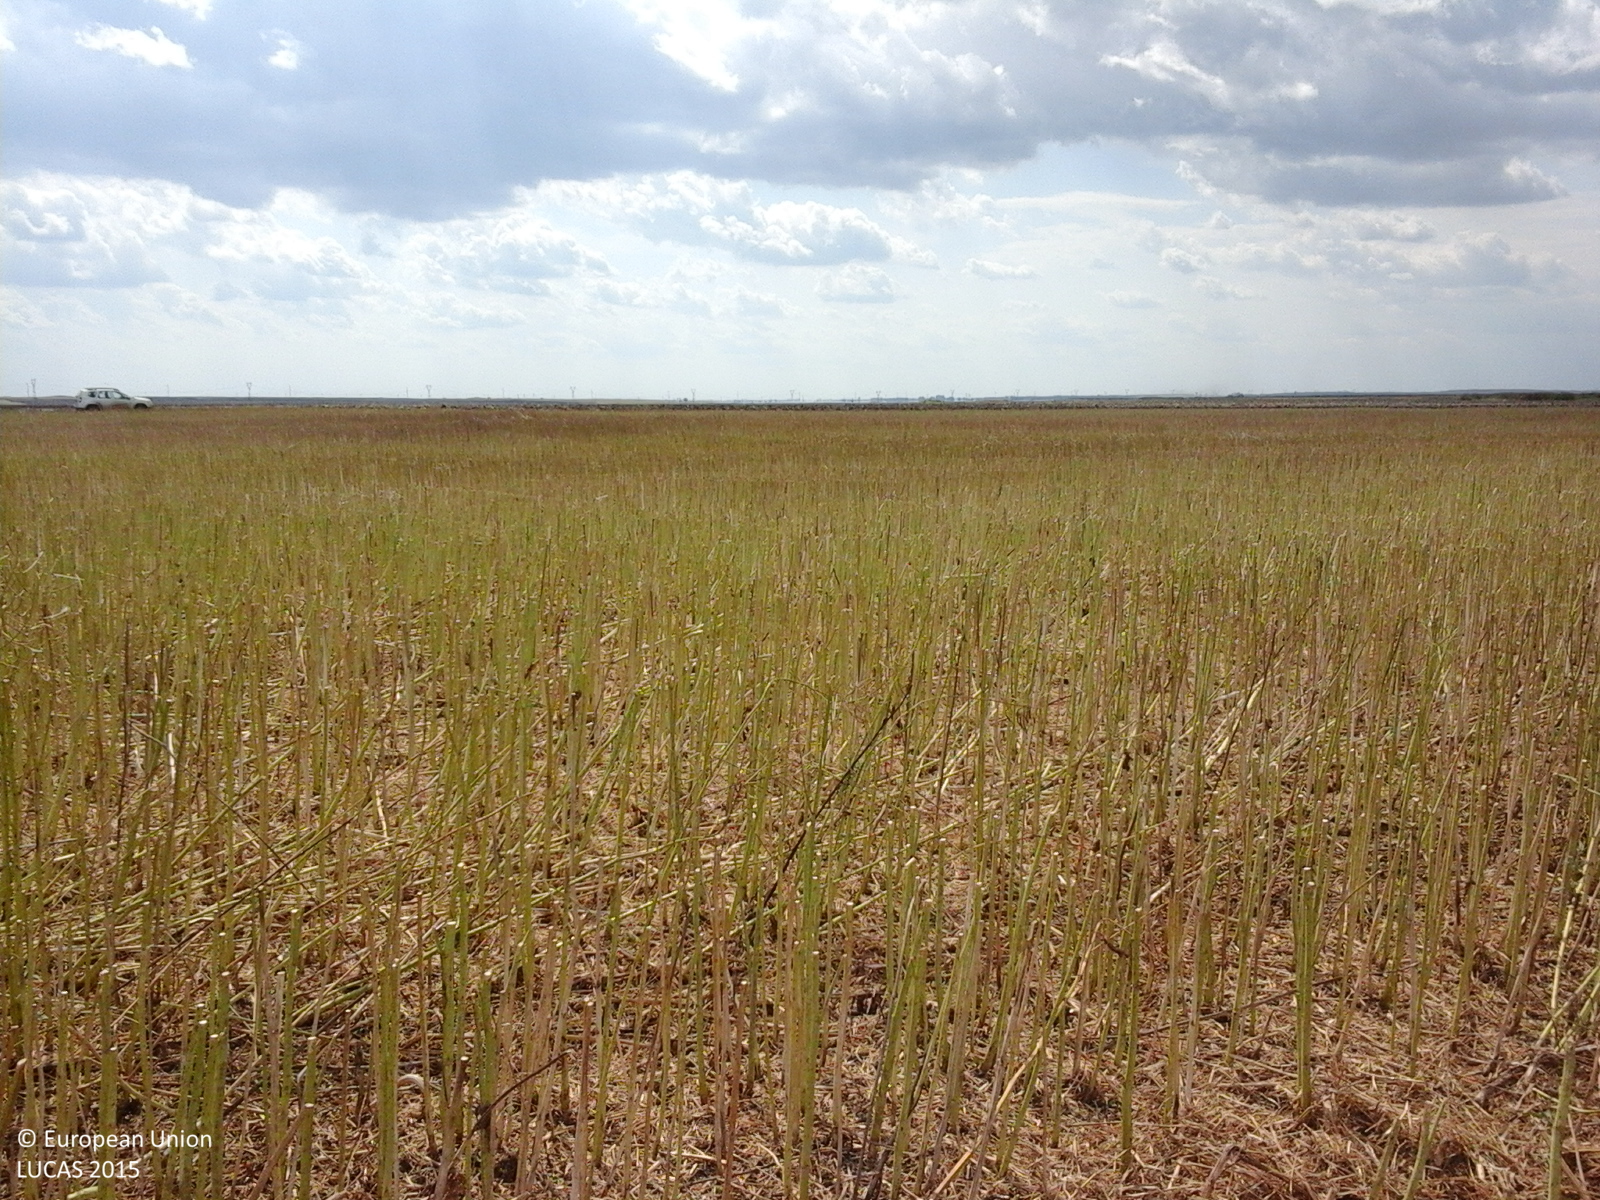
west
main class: Cropland
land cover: Rape and turnip rape
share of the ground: < 10 %
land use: Agriculture (excluding fallow land and kitchen gardens)
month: July
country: RO
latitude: 43.8871
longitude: 24.5424
